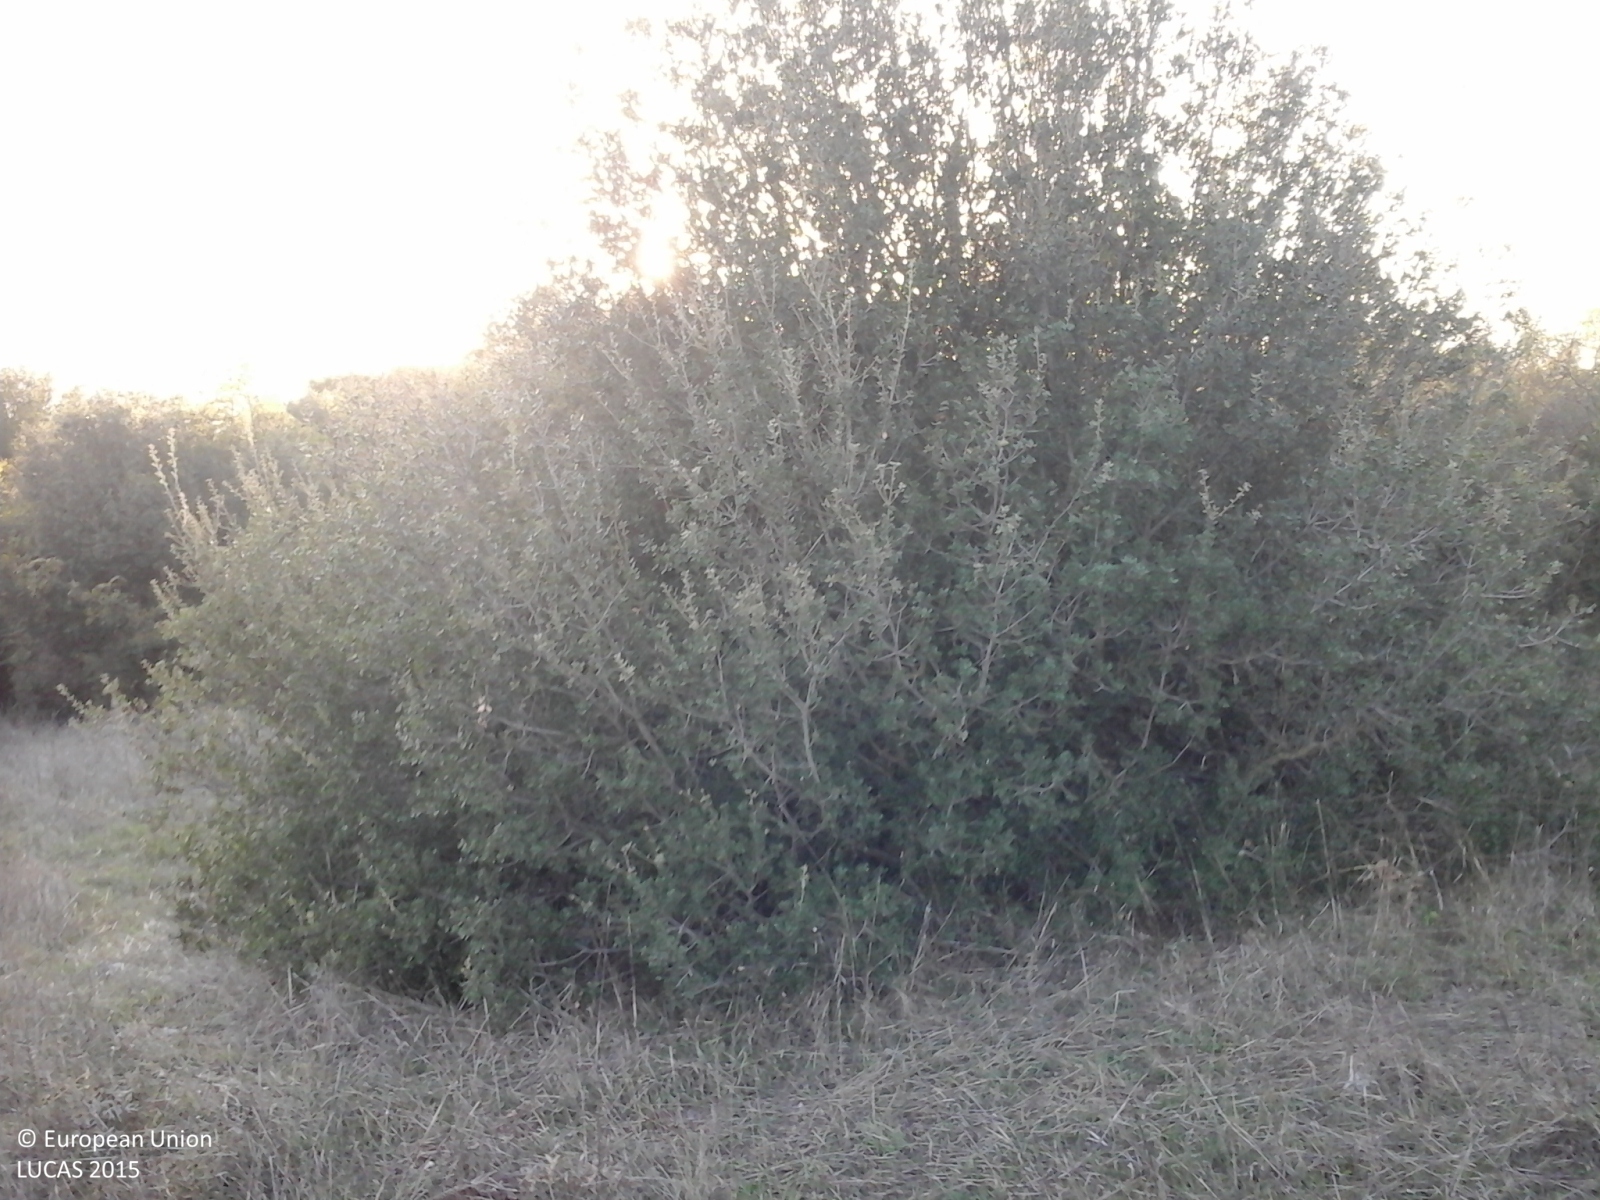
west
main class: Grassland
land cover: Grassland with sparse tree/shrub cover
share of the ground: > 75 %
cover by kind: herbaceous plants 80 %, shrubs 10 %, broadleaved forest trees 5 %, unconsolidated bare surface 5 %
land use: Semi-natural and natural areas not in use
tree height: > 5 m
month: September
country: GR
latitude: 39.8321
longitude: 20.6472
